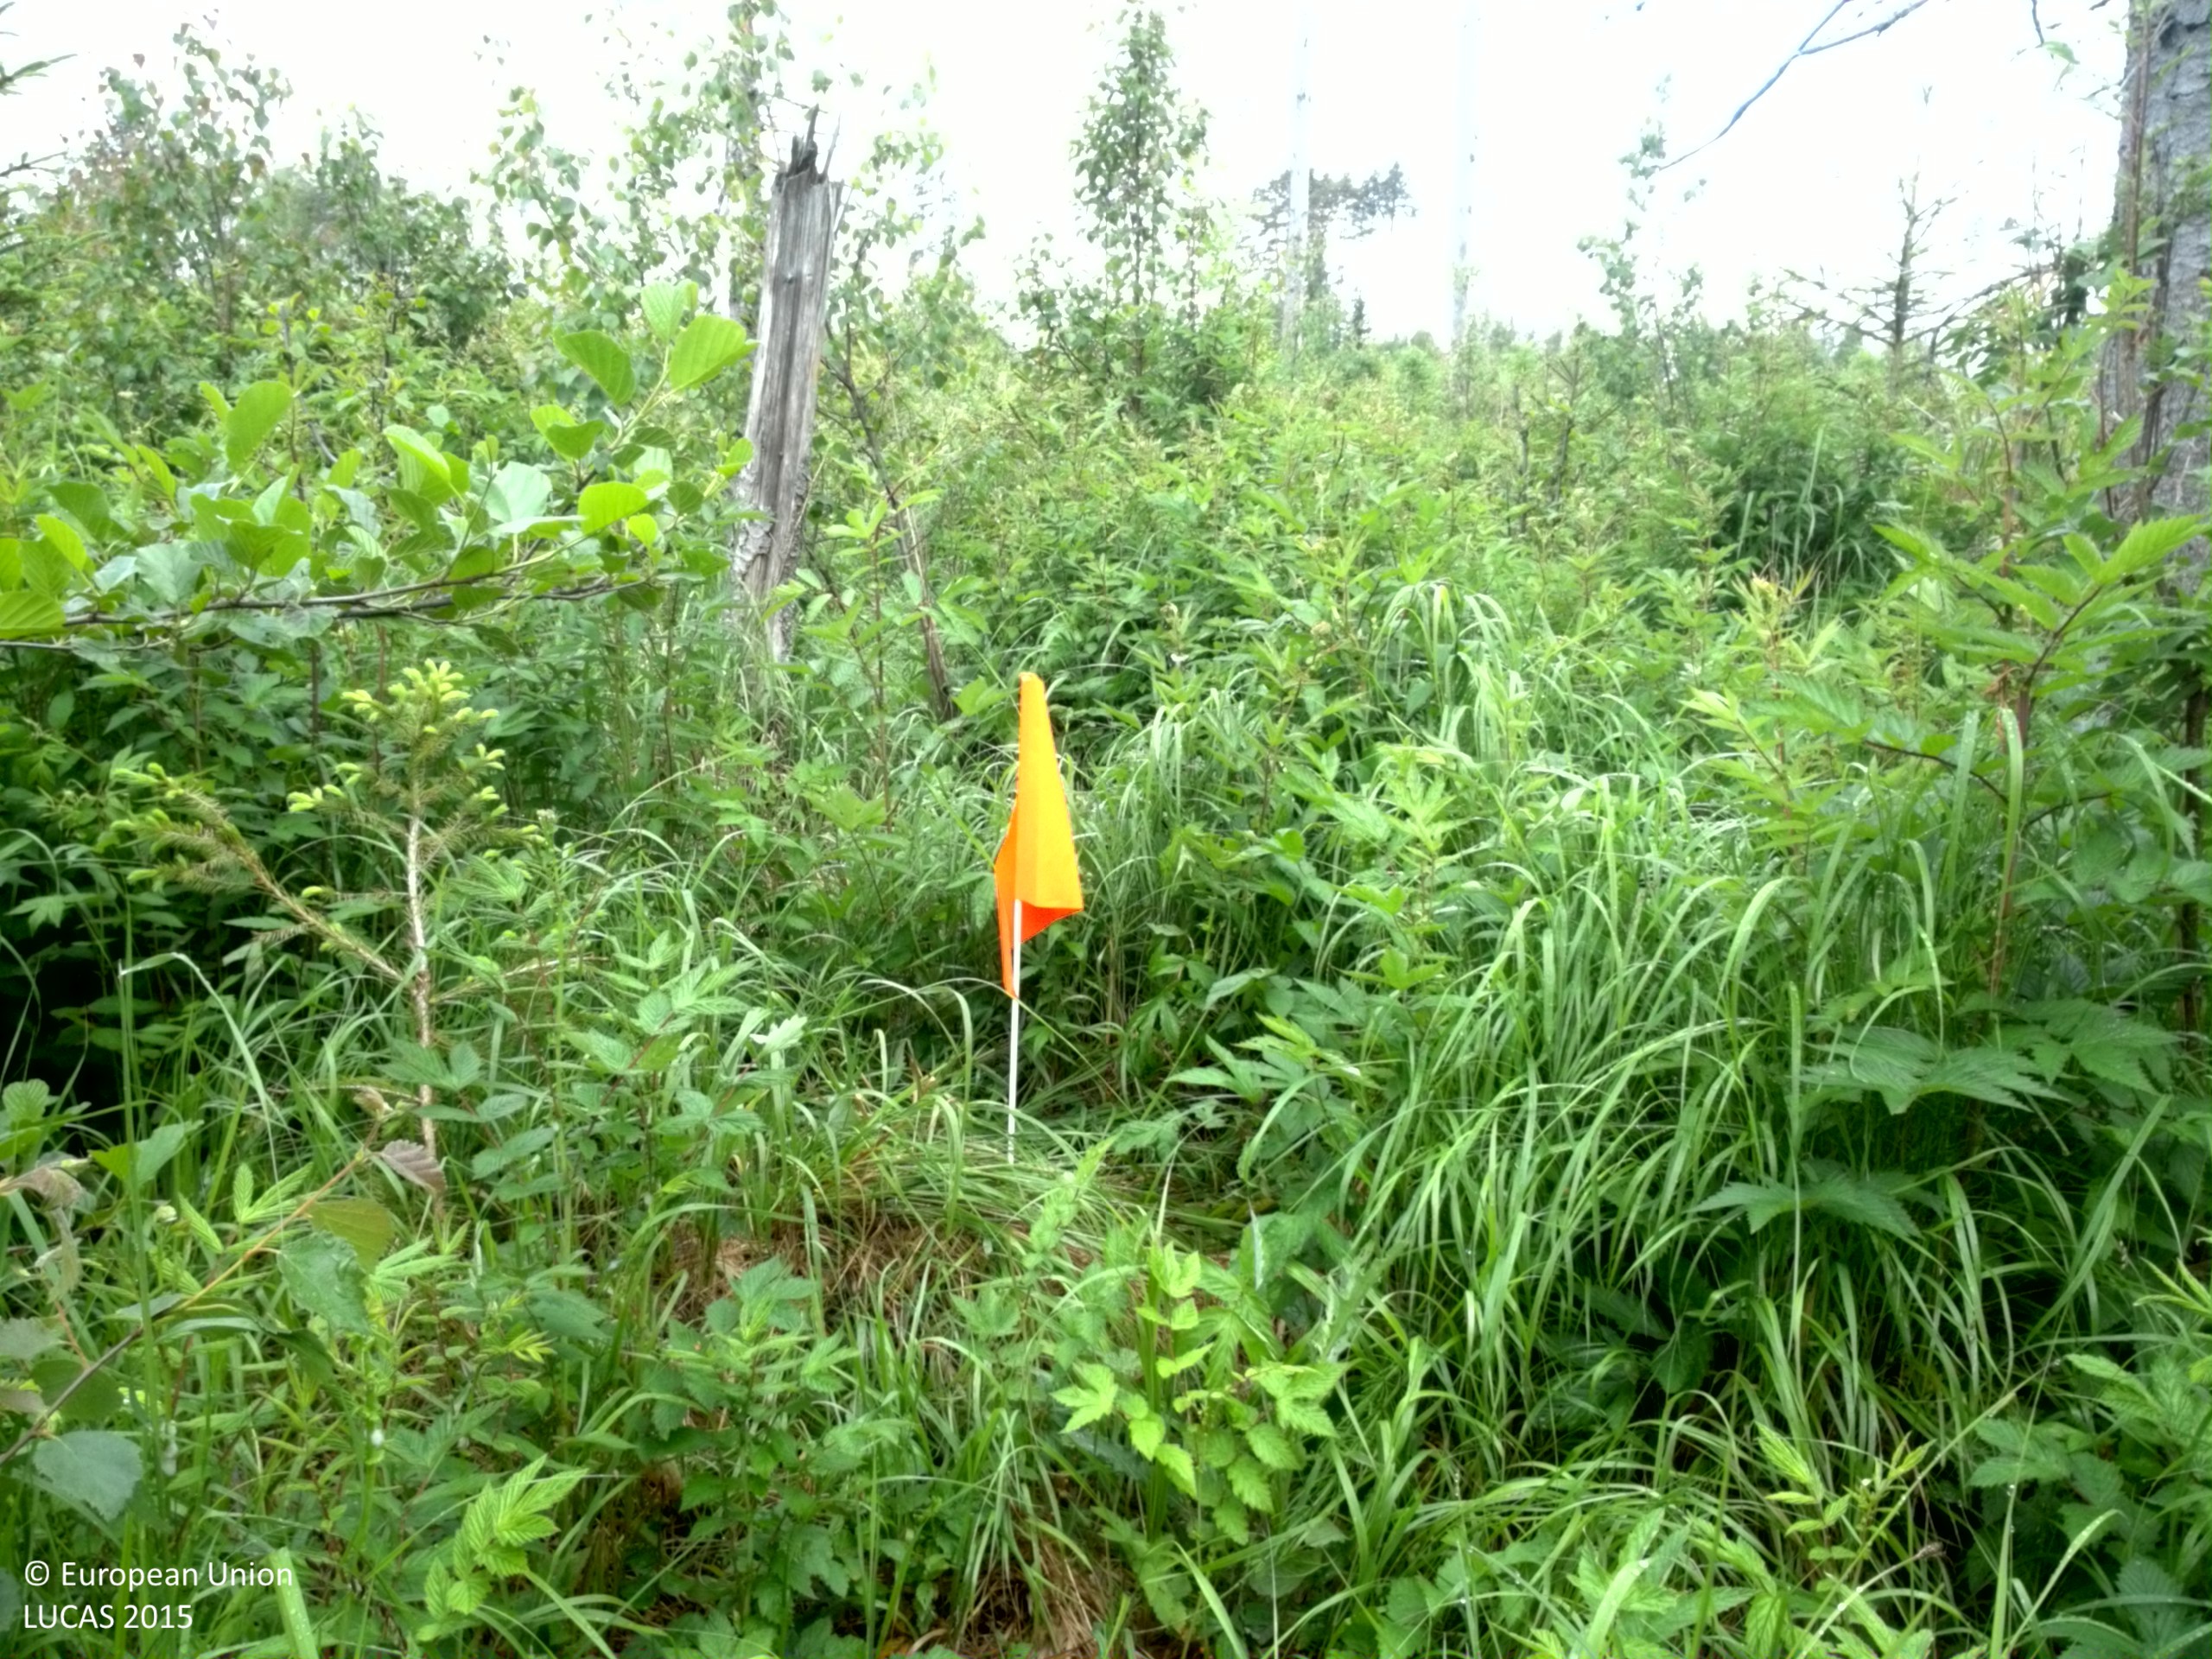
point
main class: Woodland
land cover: Broadleaved woodland
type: boreal forest
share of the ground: 25 - 50 %
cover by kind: broadleaved forest trees 45 %, herbaceous plants 30 %, shrubs 15 %, coniferous forest trees 5 %
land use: Forestry
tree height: < 5 m
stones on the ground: < 10 %
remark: Clear cut
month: June
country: SE
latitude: 60.3028
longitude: 17.5742
